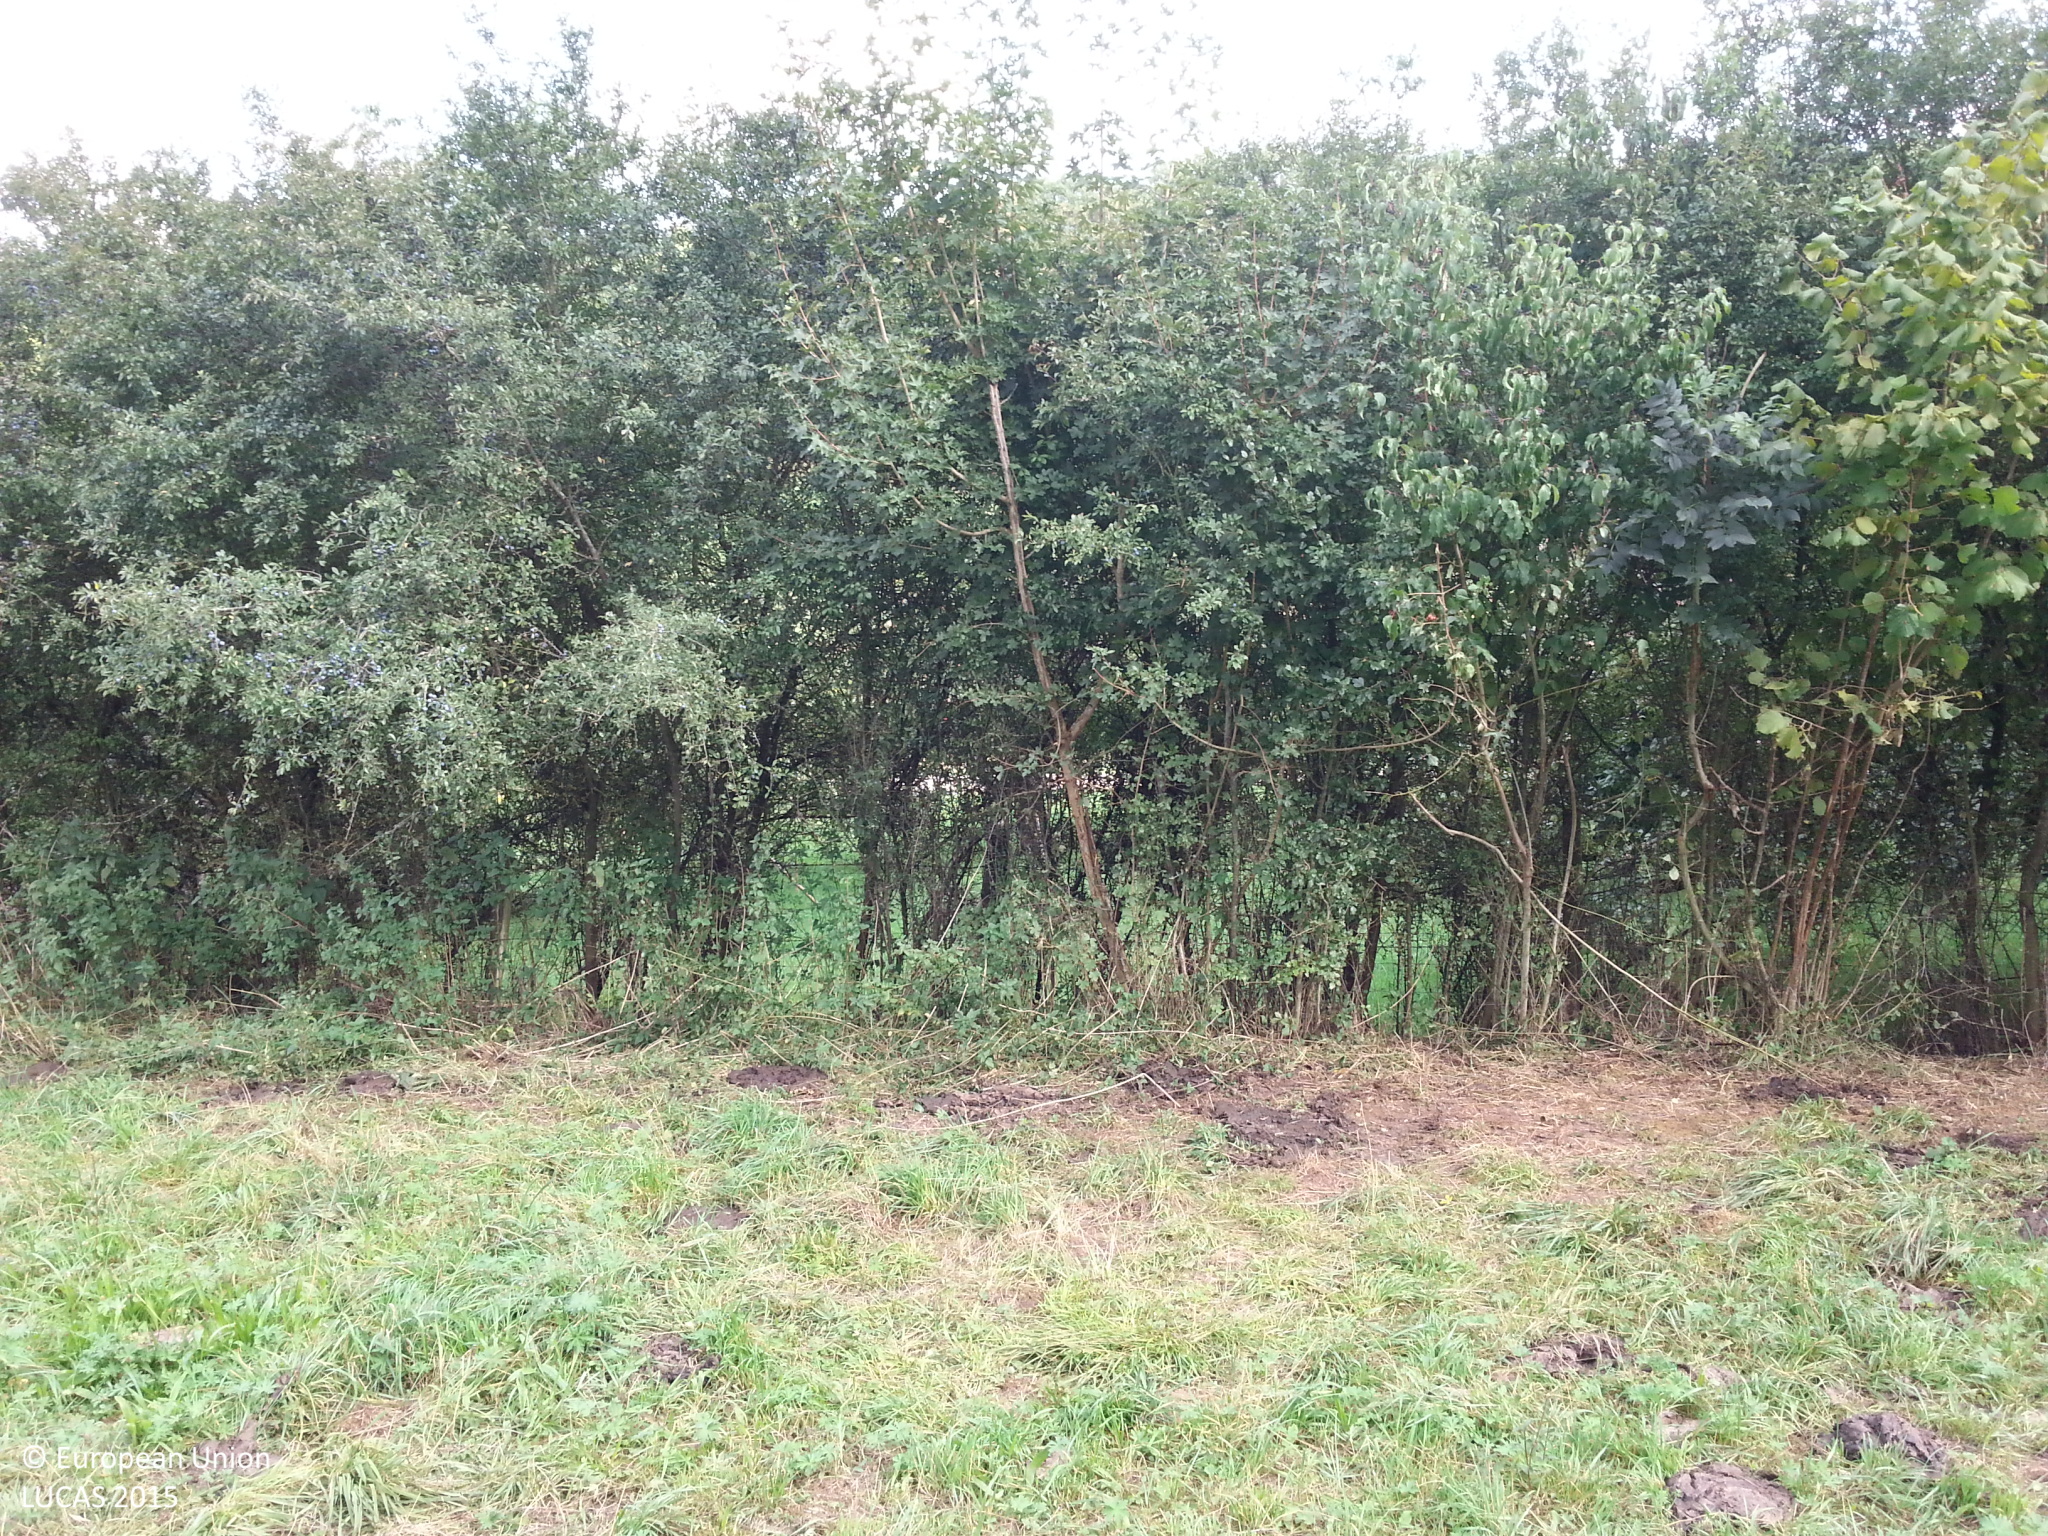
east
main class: Grassland
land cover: Grassland without tree/shrub cover
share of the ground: > 75 %
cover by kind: herbaceous plants 100 %
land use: Agriculture (excluding fallow land and kitchen gardens)
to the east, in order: Grassland without tree/shrub cover; Fences; Abandoned hedges; Apple fruit; Fences; Grass margins; Paved roads, cycling and walking lanes; Grass margins; Fences; Grassland without tree/shrub cover; Broadleaved woodland; Rivers and streams; Broadleaved woodland; Grassland without tree/shrub cover; Abandoned hedges; Grassland without tree/shrub cover; Broadleaved woodland; Grassland without tree/shrub cover; Abandoned hedges; Grassland without tree/shrub cover
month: September
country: DE
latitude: 49.3929
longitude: 9.9036
